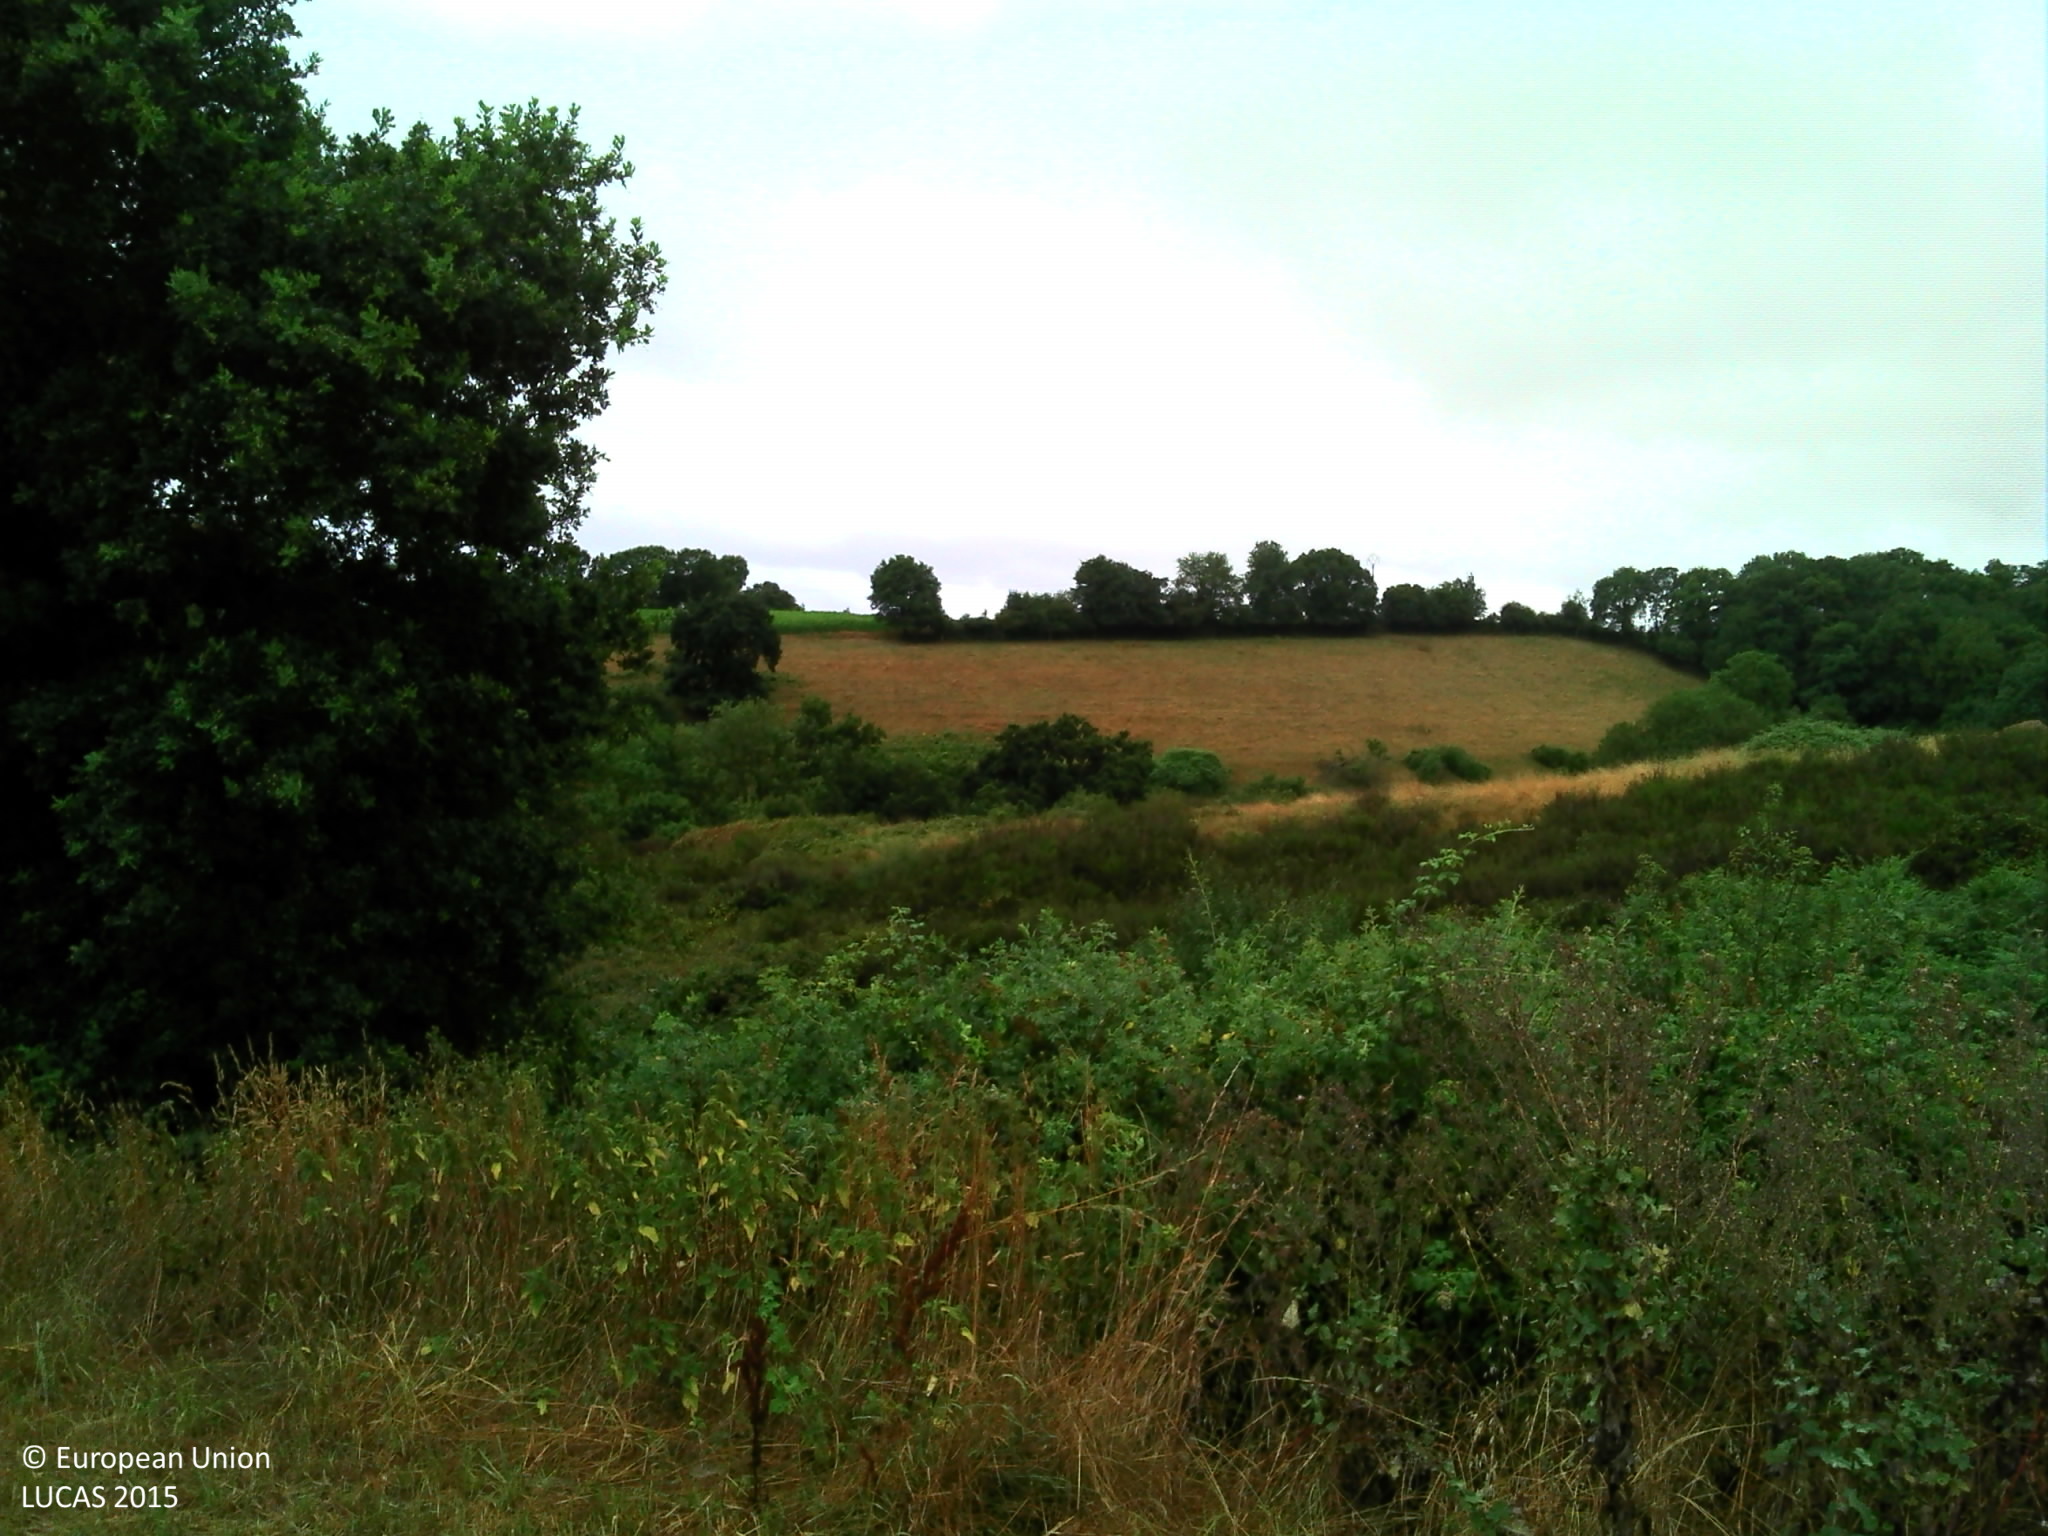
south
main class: Cropland
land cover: Temporary grasslands
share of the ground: > 75 %
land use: Agriculture (excluding fallow land and kitchen gardens)
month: July
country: FR
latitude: 48.3153
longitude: -0.1577
